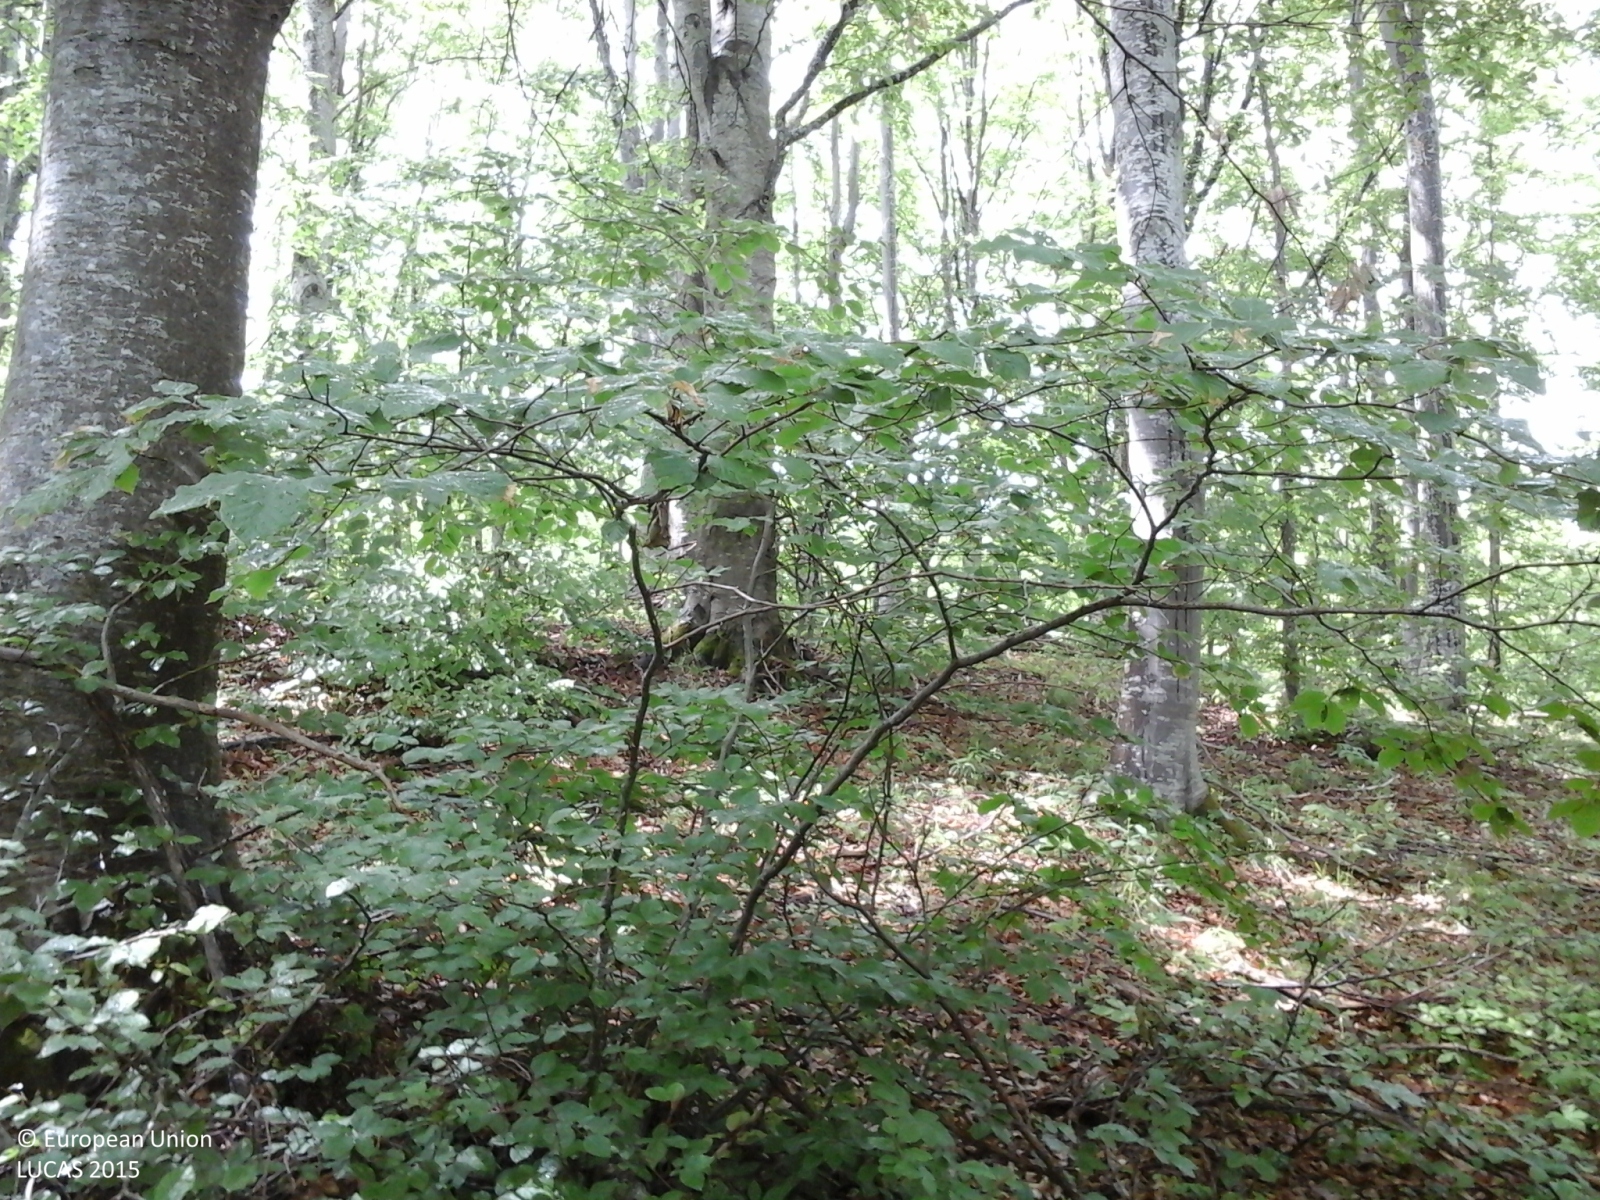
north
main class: Woodland
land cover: Broadleaved woodland
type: mountainous beech forest
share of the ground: > 75 %
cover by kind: broadleaved forest trees 90 %, shrubs 10 %
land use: Forestry
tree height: > 5 m
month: May
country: IT
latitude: 44.4767
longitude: 10.1631
